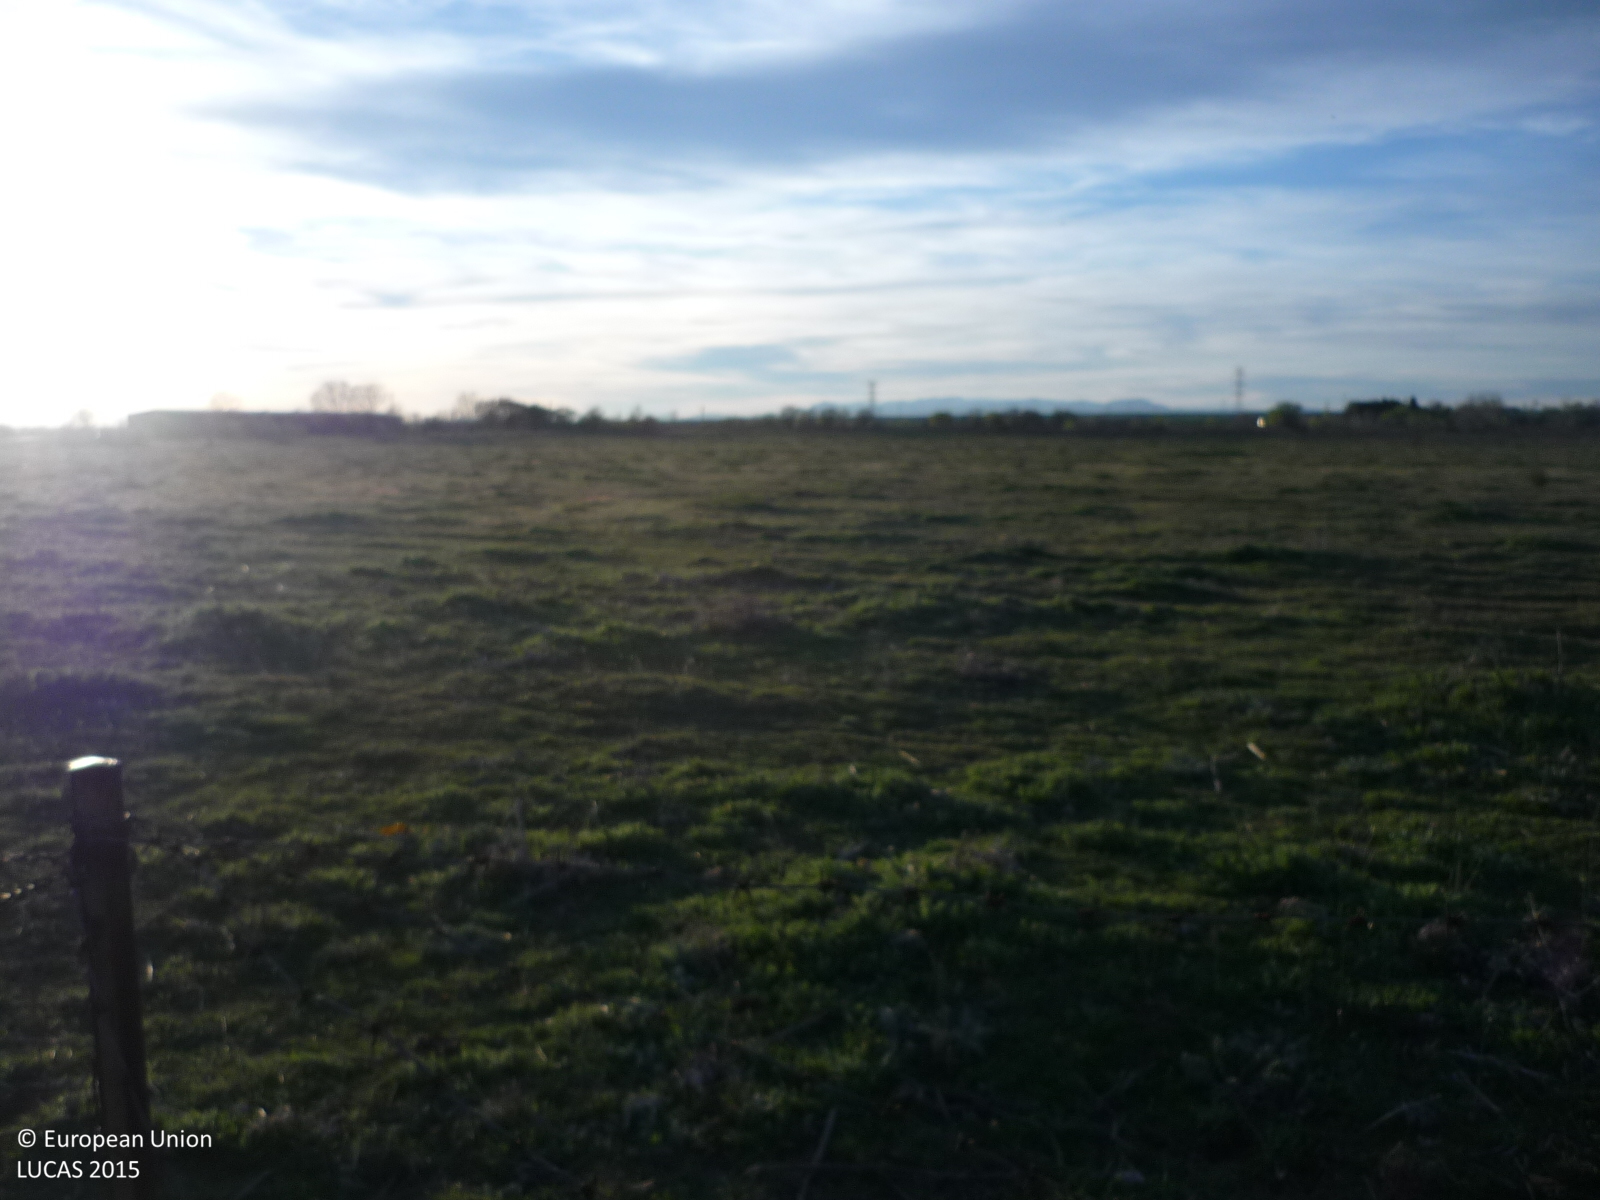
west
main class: Grassland
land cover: Grassland without tree/shrub cover
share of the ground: > 75 %
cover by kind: herbaceous plants 100 %
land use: Semi-natural and natural areas not in use
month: March
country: ES
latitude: 40.5239
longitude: -3.3372
